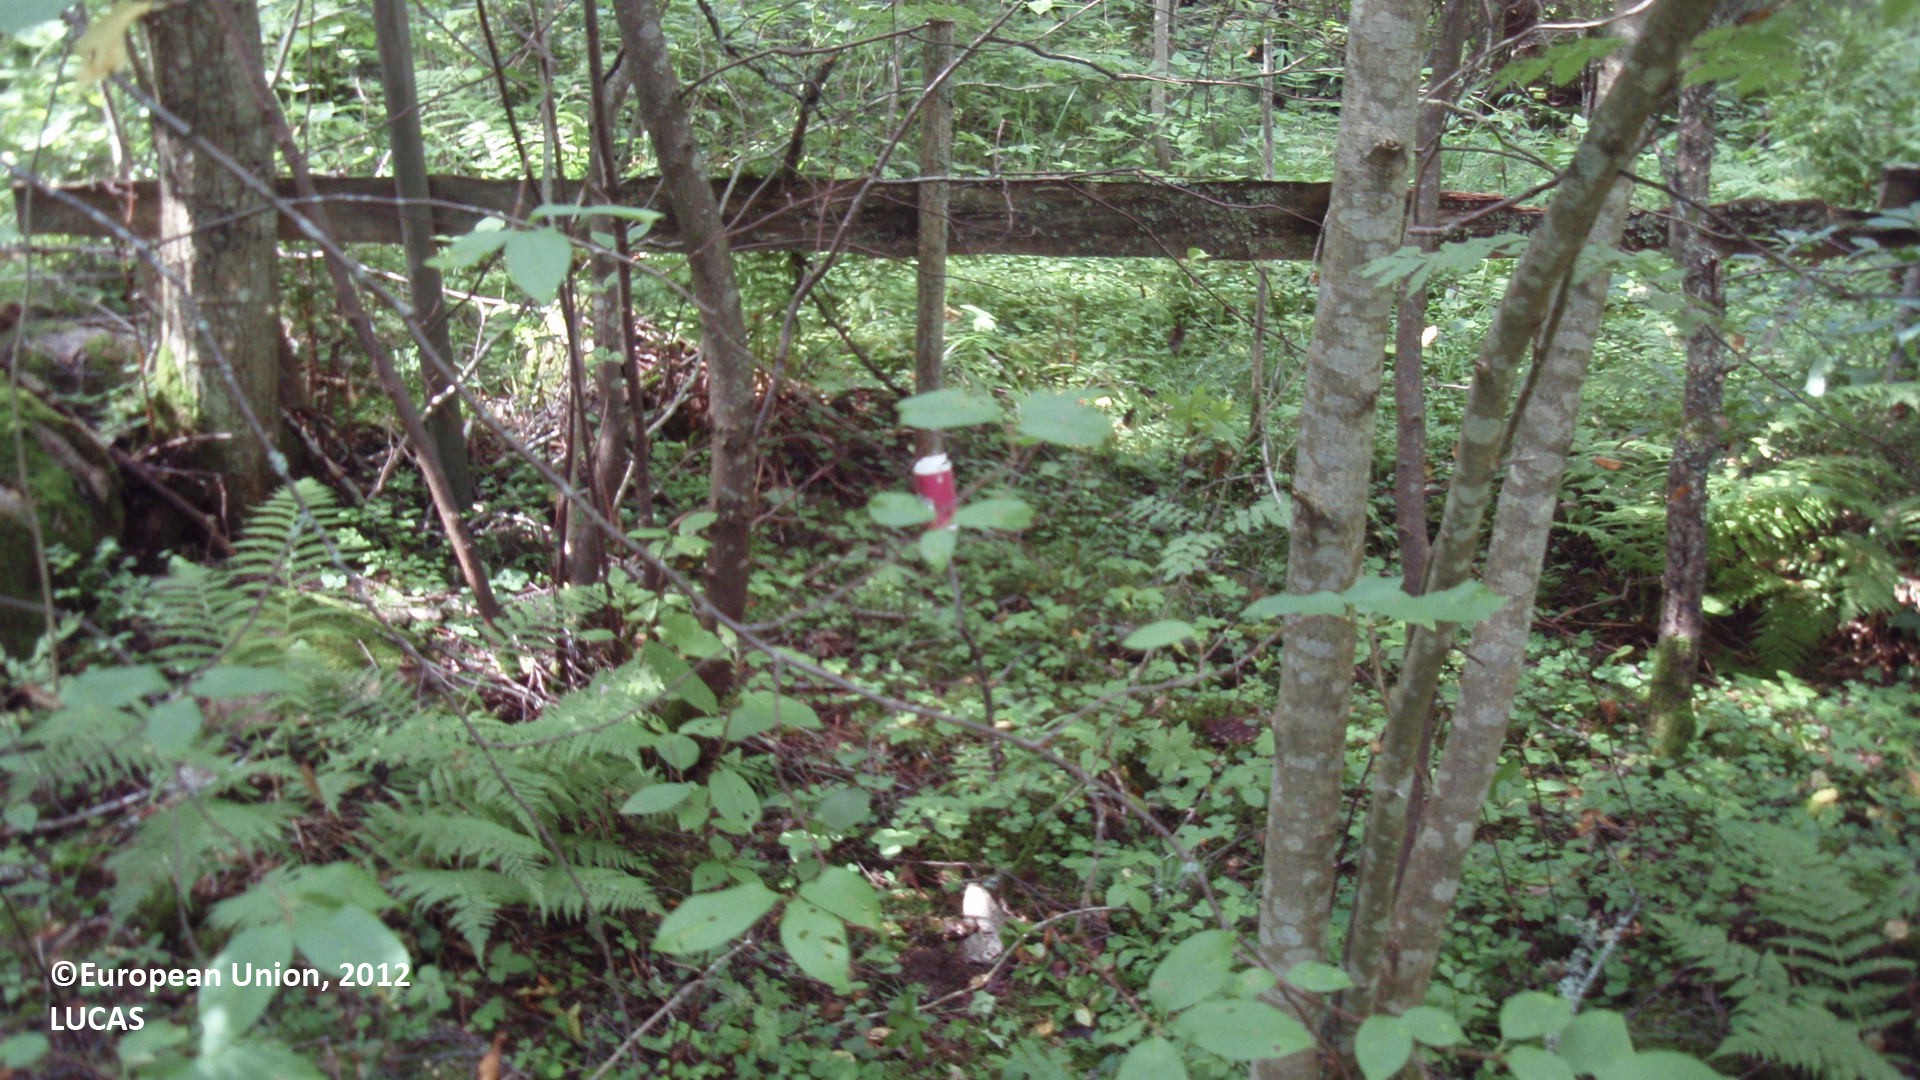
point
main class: Woodland
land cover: Broadleaved woodland
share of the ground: 50 - 75 %
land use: Forestry
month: August
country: FI
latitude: 61.0484
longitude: 27.9951
